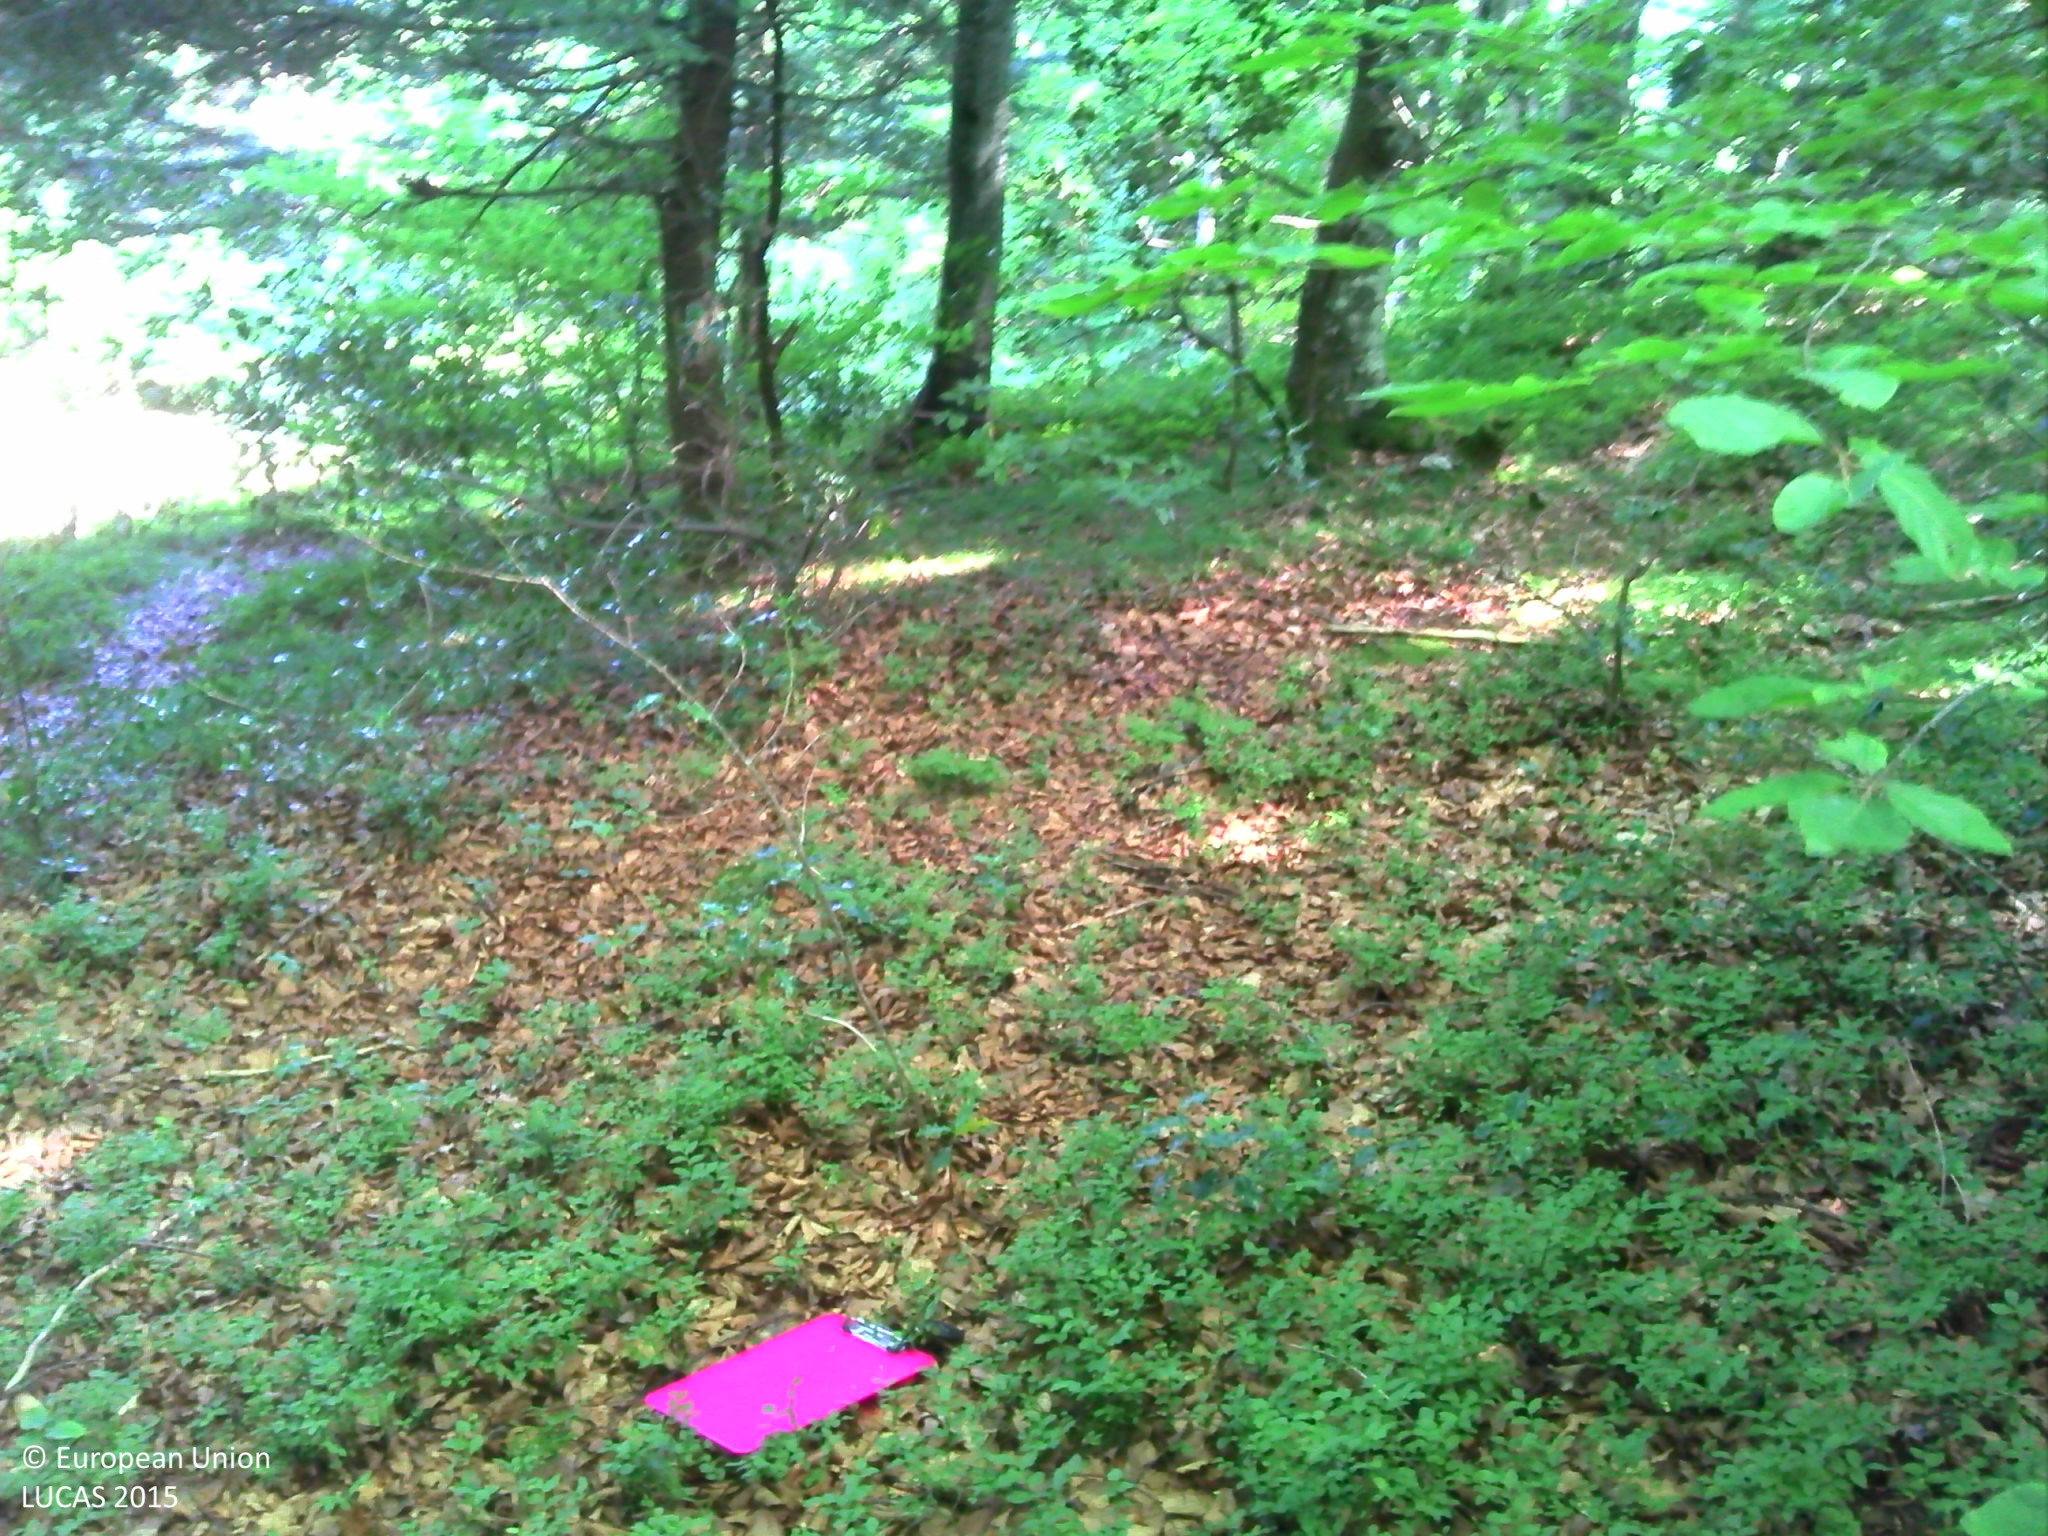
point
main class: Woodland
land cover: Spruce dominated mixed woodland
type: mountainous beech forest
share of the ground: > 75 %
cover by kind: broadleaved forest trees 55 %, coniferous forest trees 20 %, unconsolidated bare surface 15 %, herbaceous plants 10 %
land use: Forestry
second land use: Sport
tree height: > 5 m
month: August
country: FR
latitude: 42.9623
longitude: 1.4370
